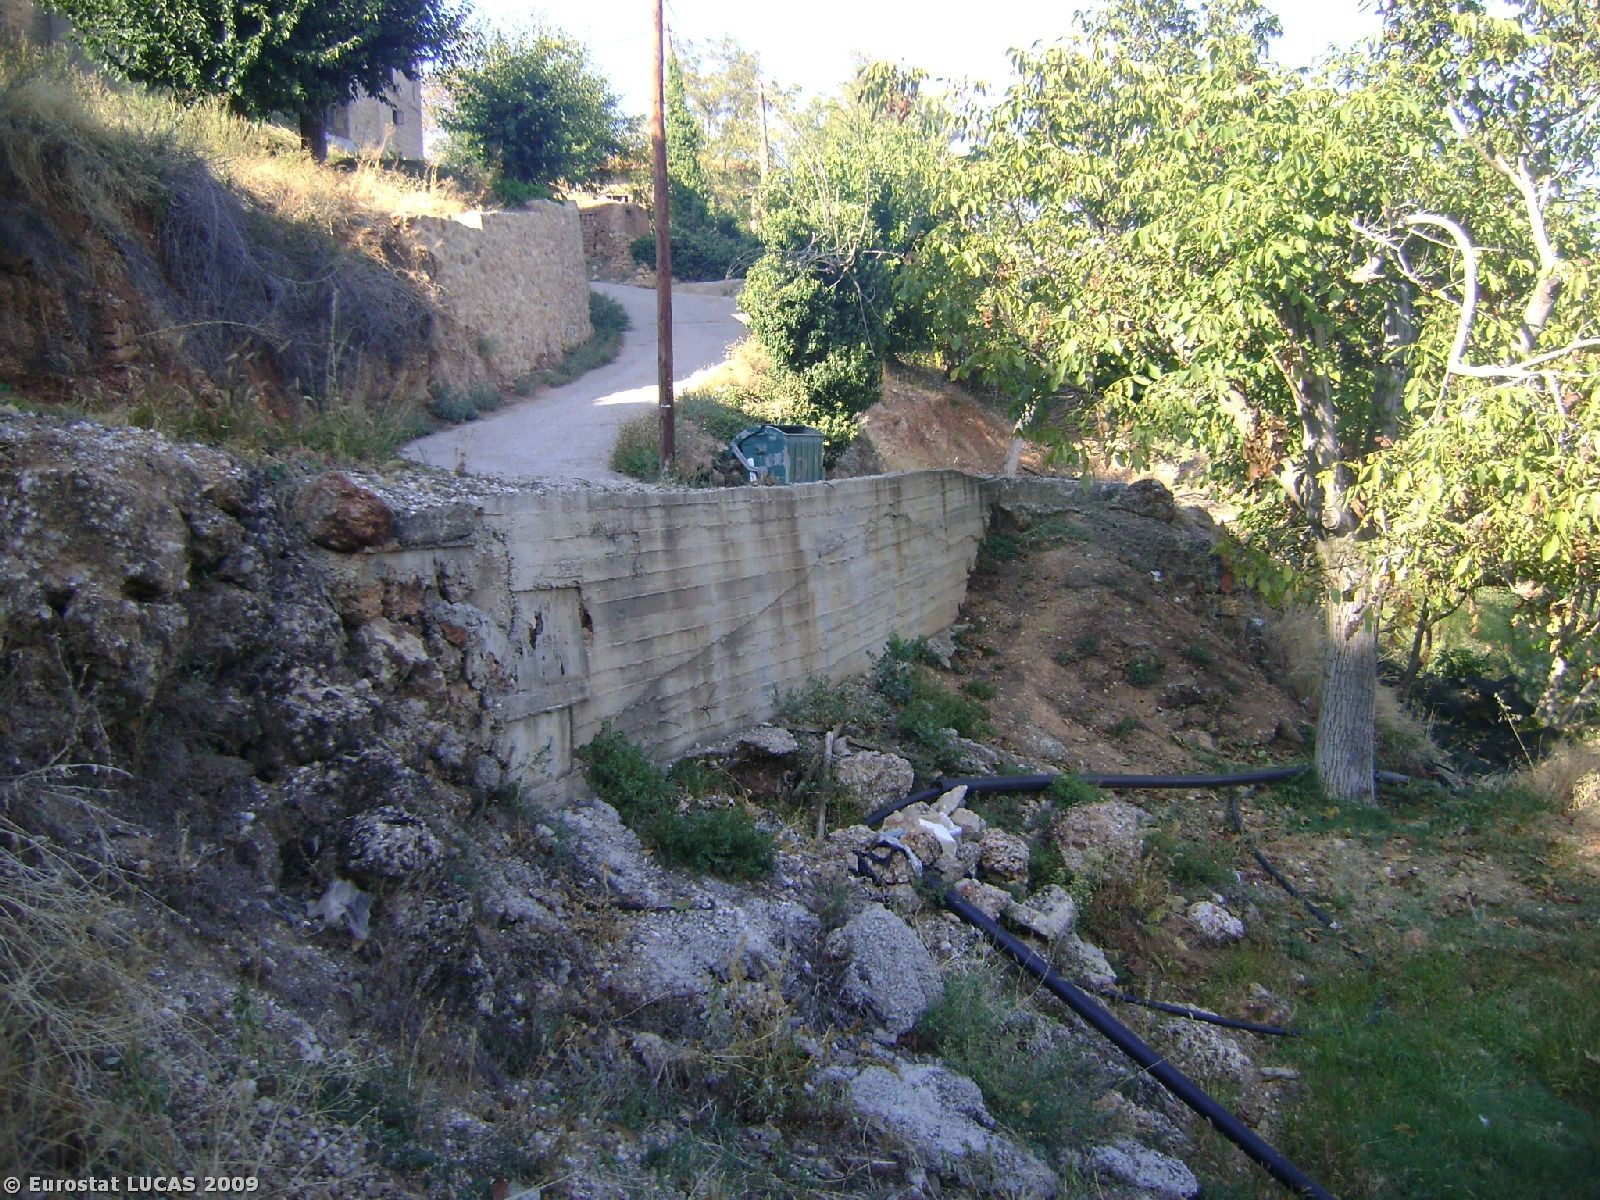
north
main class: Grassland
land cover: Grassland without tree/shrub cover
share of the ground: > 75 %
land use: Unused
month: October
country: GR
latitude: 38.0973
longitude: 22.3190
